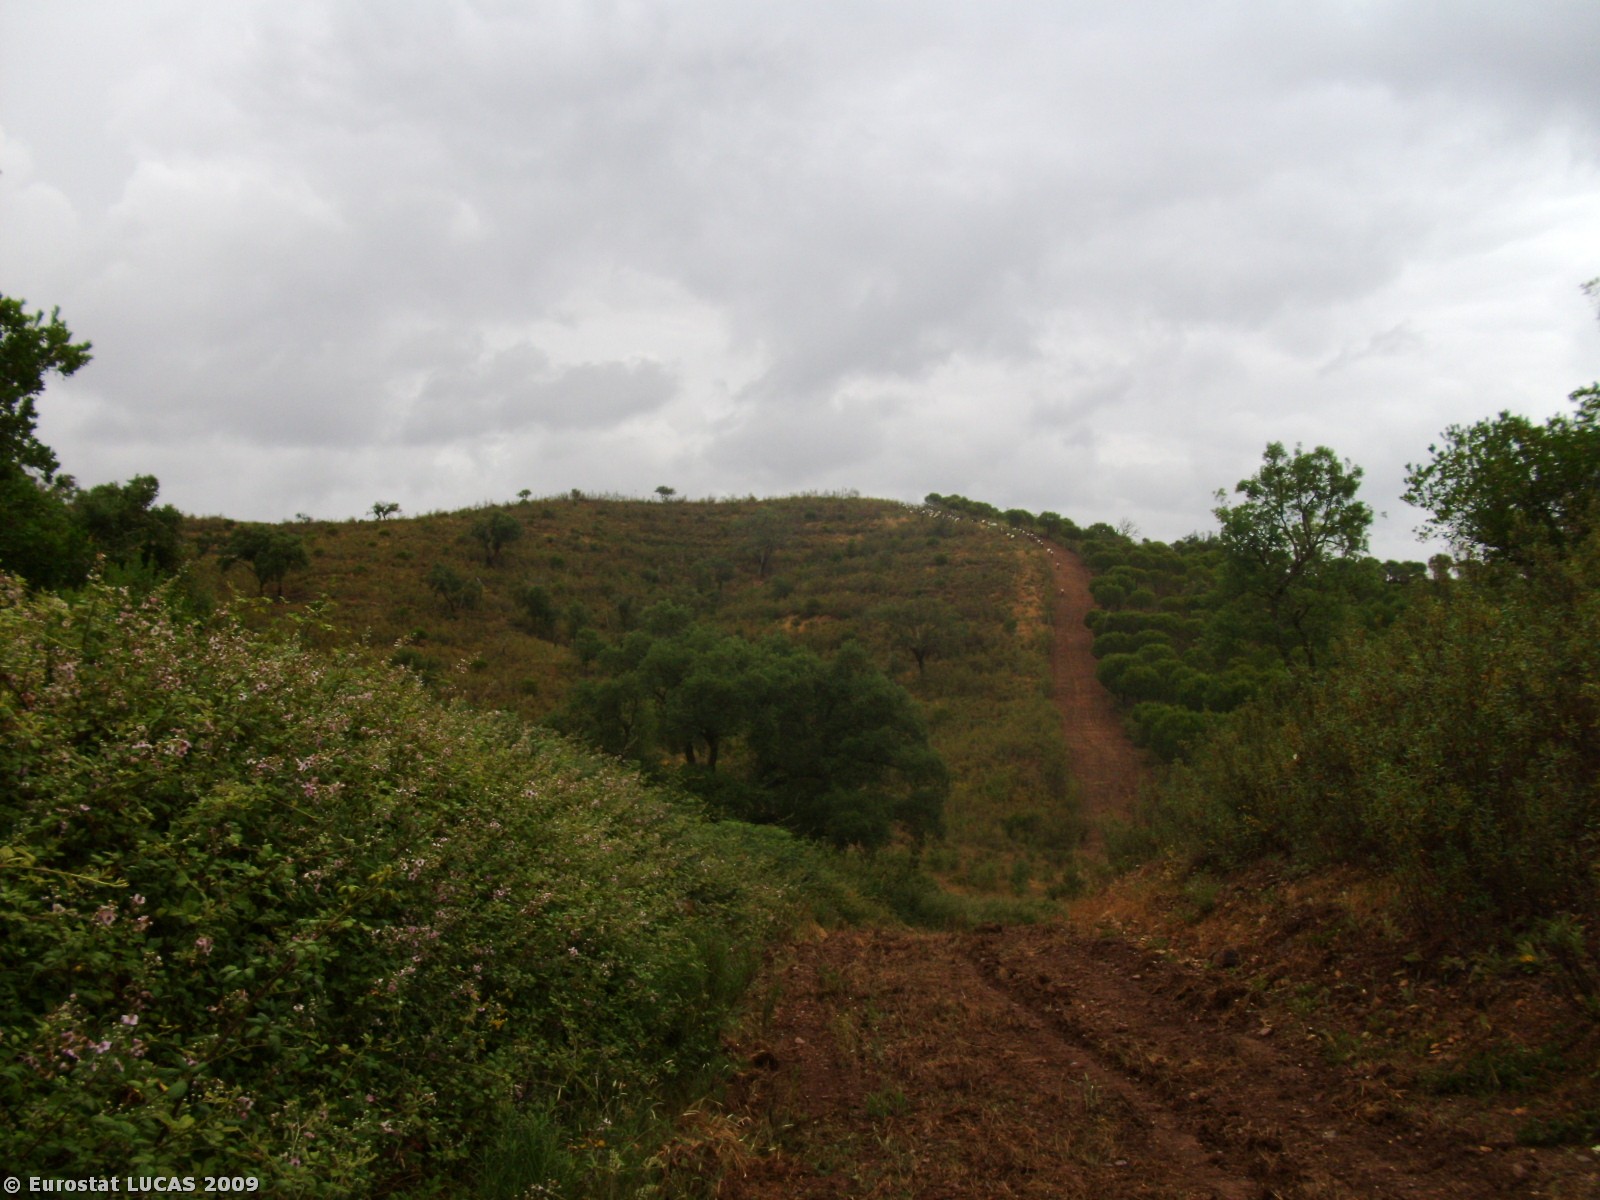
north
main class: Shrubland
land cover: Shrubland with sparse tree cover
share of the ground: > 75 %
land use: Fallow land
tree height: > 5 m
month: June
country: PT
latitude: 37.3892
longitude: -8.4507
